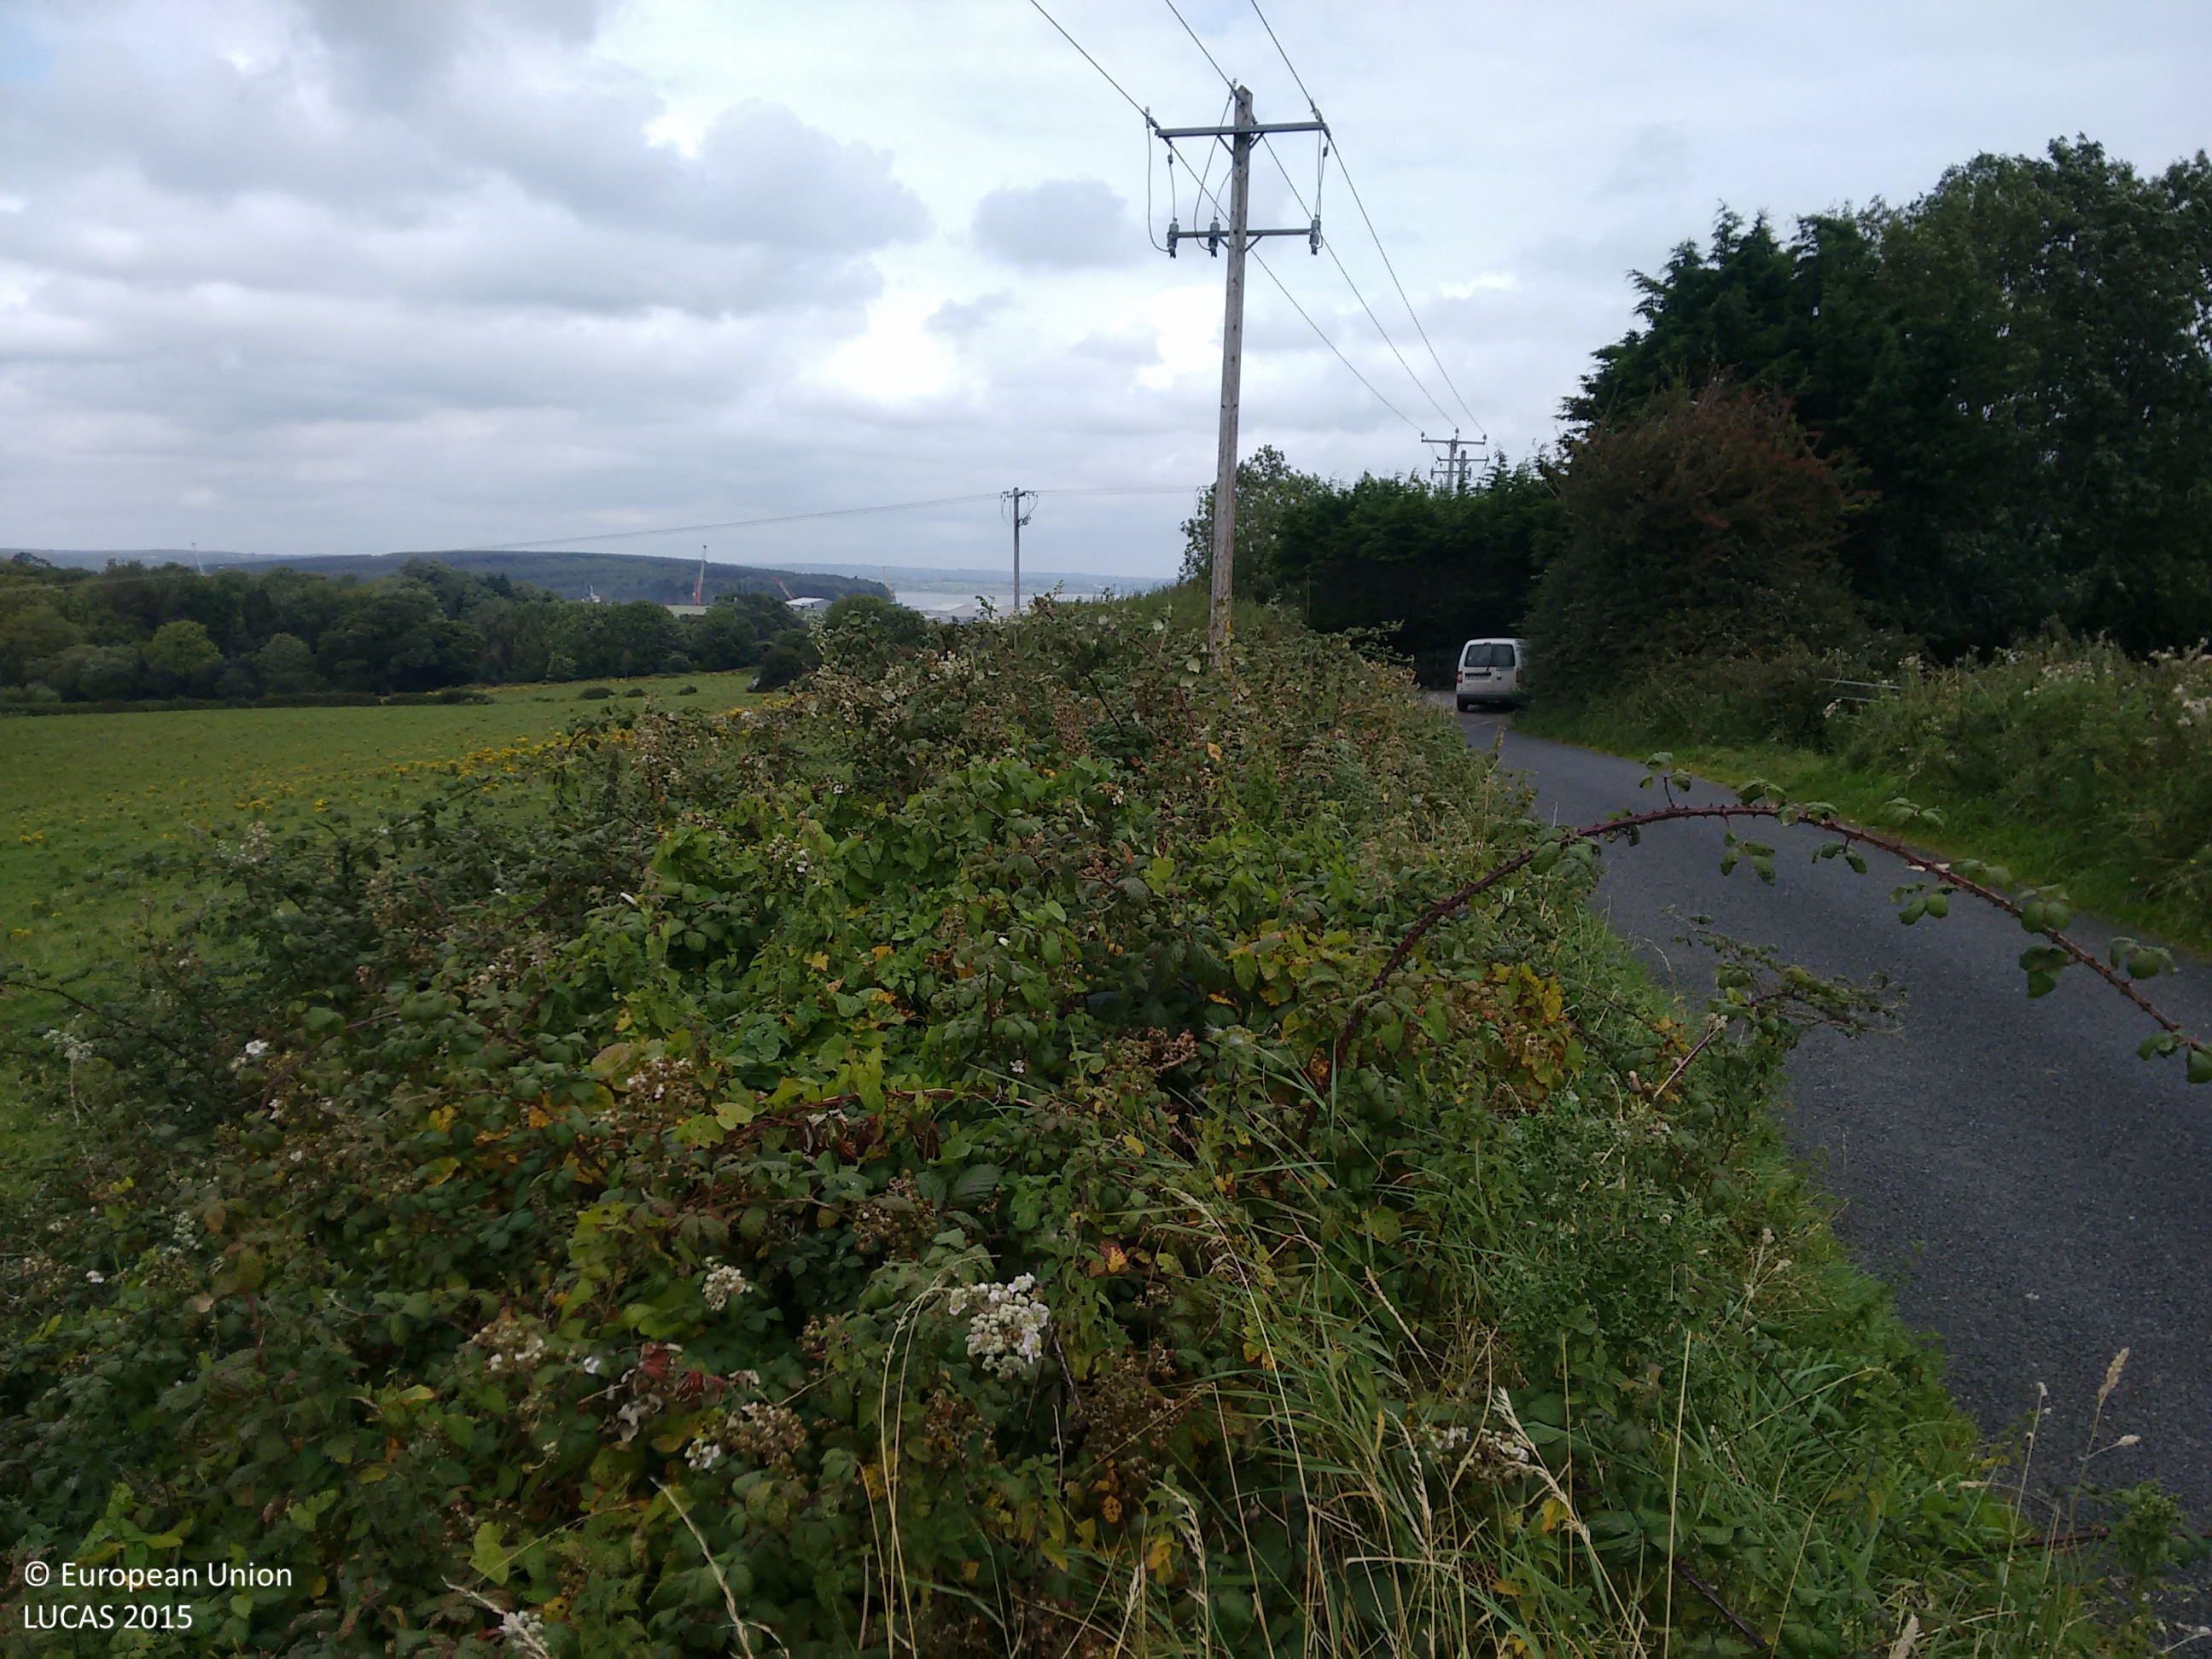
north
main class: Grassland
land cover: Grassland without tree/shrub cover
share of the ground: > 75 %
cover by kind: herbaceous plants 100 %
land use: Agriculture (excluding fallow land and kitchen gardens)
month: September
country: IE
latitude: 52.6001
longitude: -9.1006
